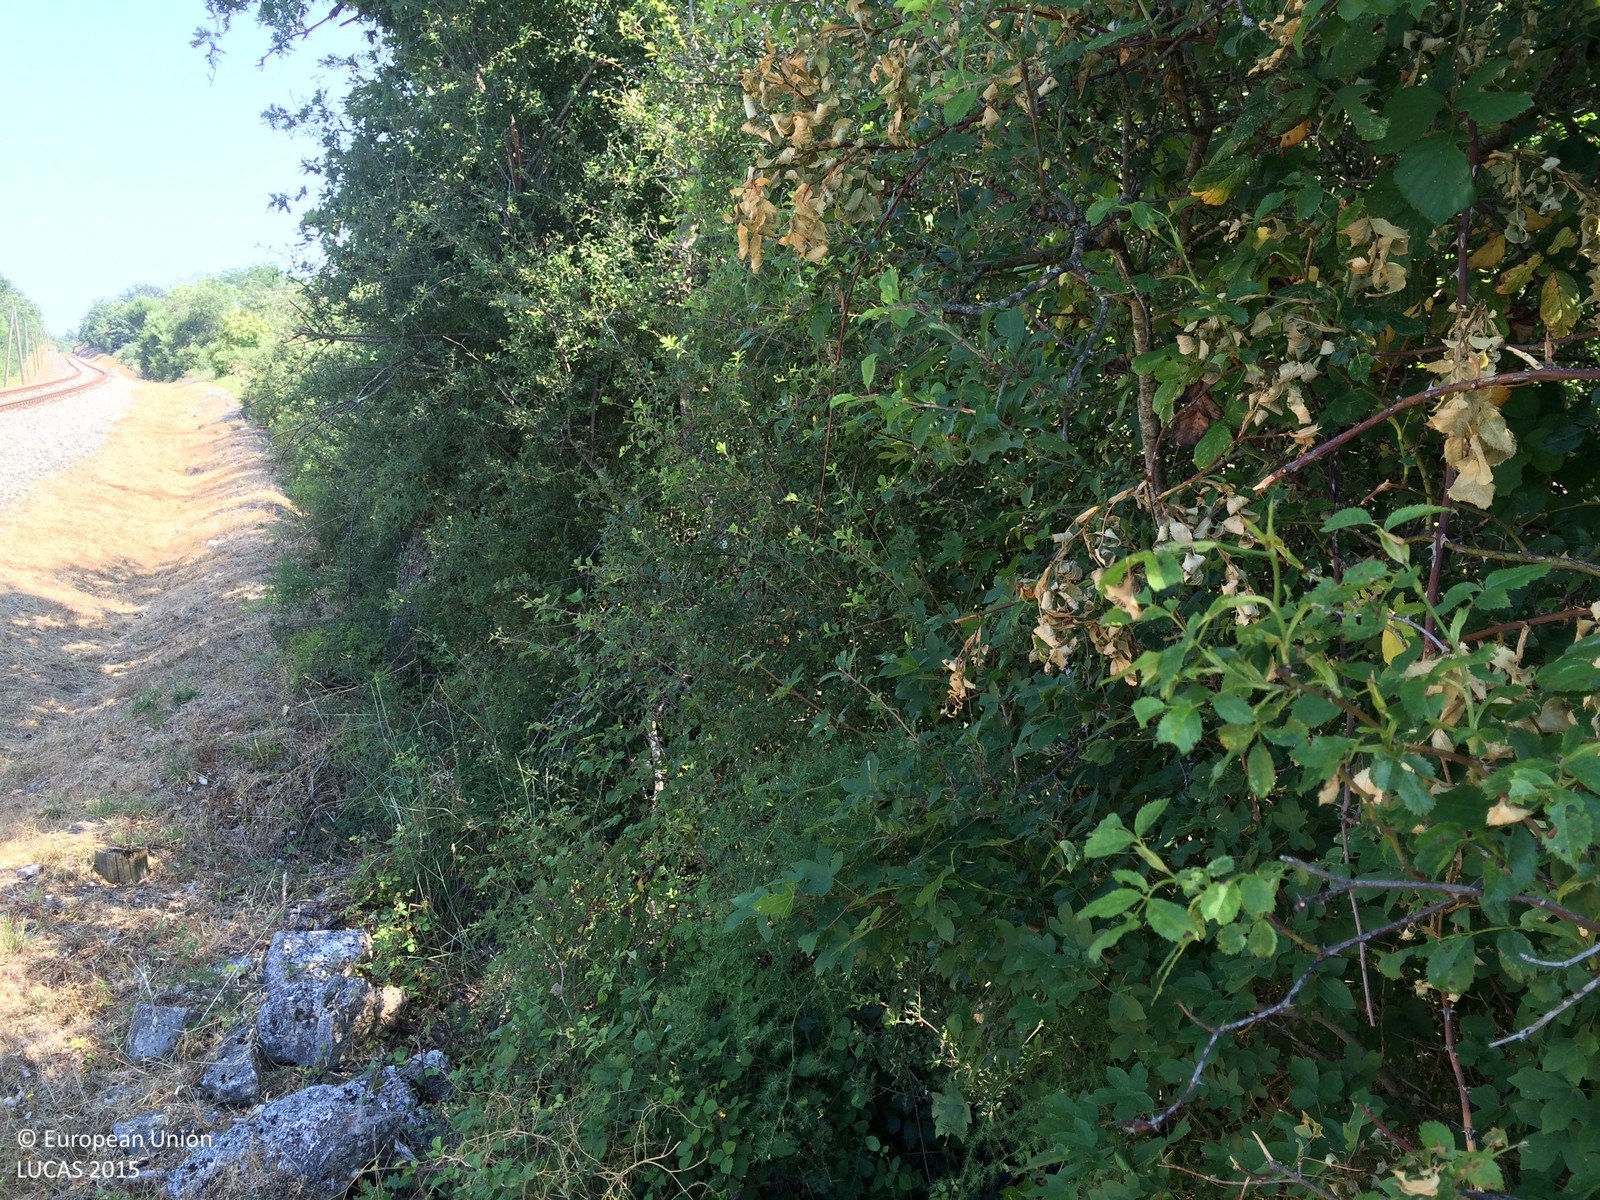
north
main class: Shrubland
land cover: Shrubland with sparse tree cover
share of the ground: < 10 %
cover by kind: shrubs 95 %, broadleaved forest trees 5 %
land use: Semi-natural and natural areas not in use
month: June
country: HR
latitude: 45.0007
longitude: 13.8636
